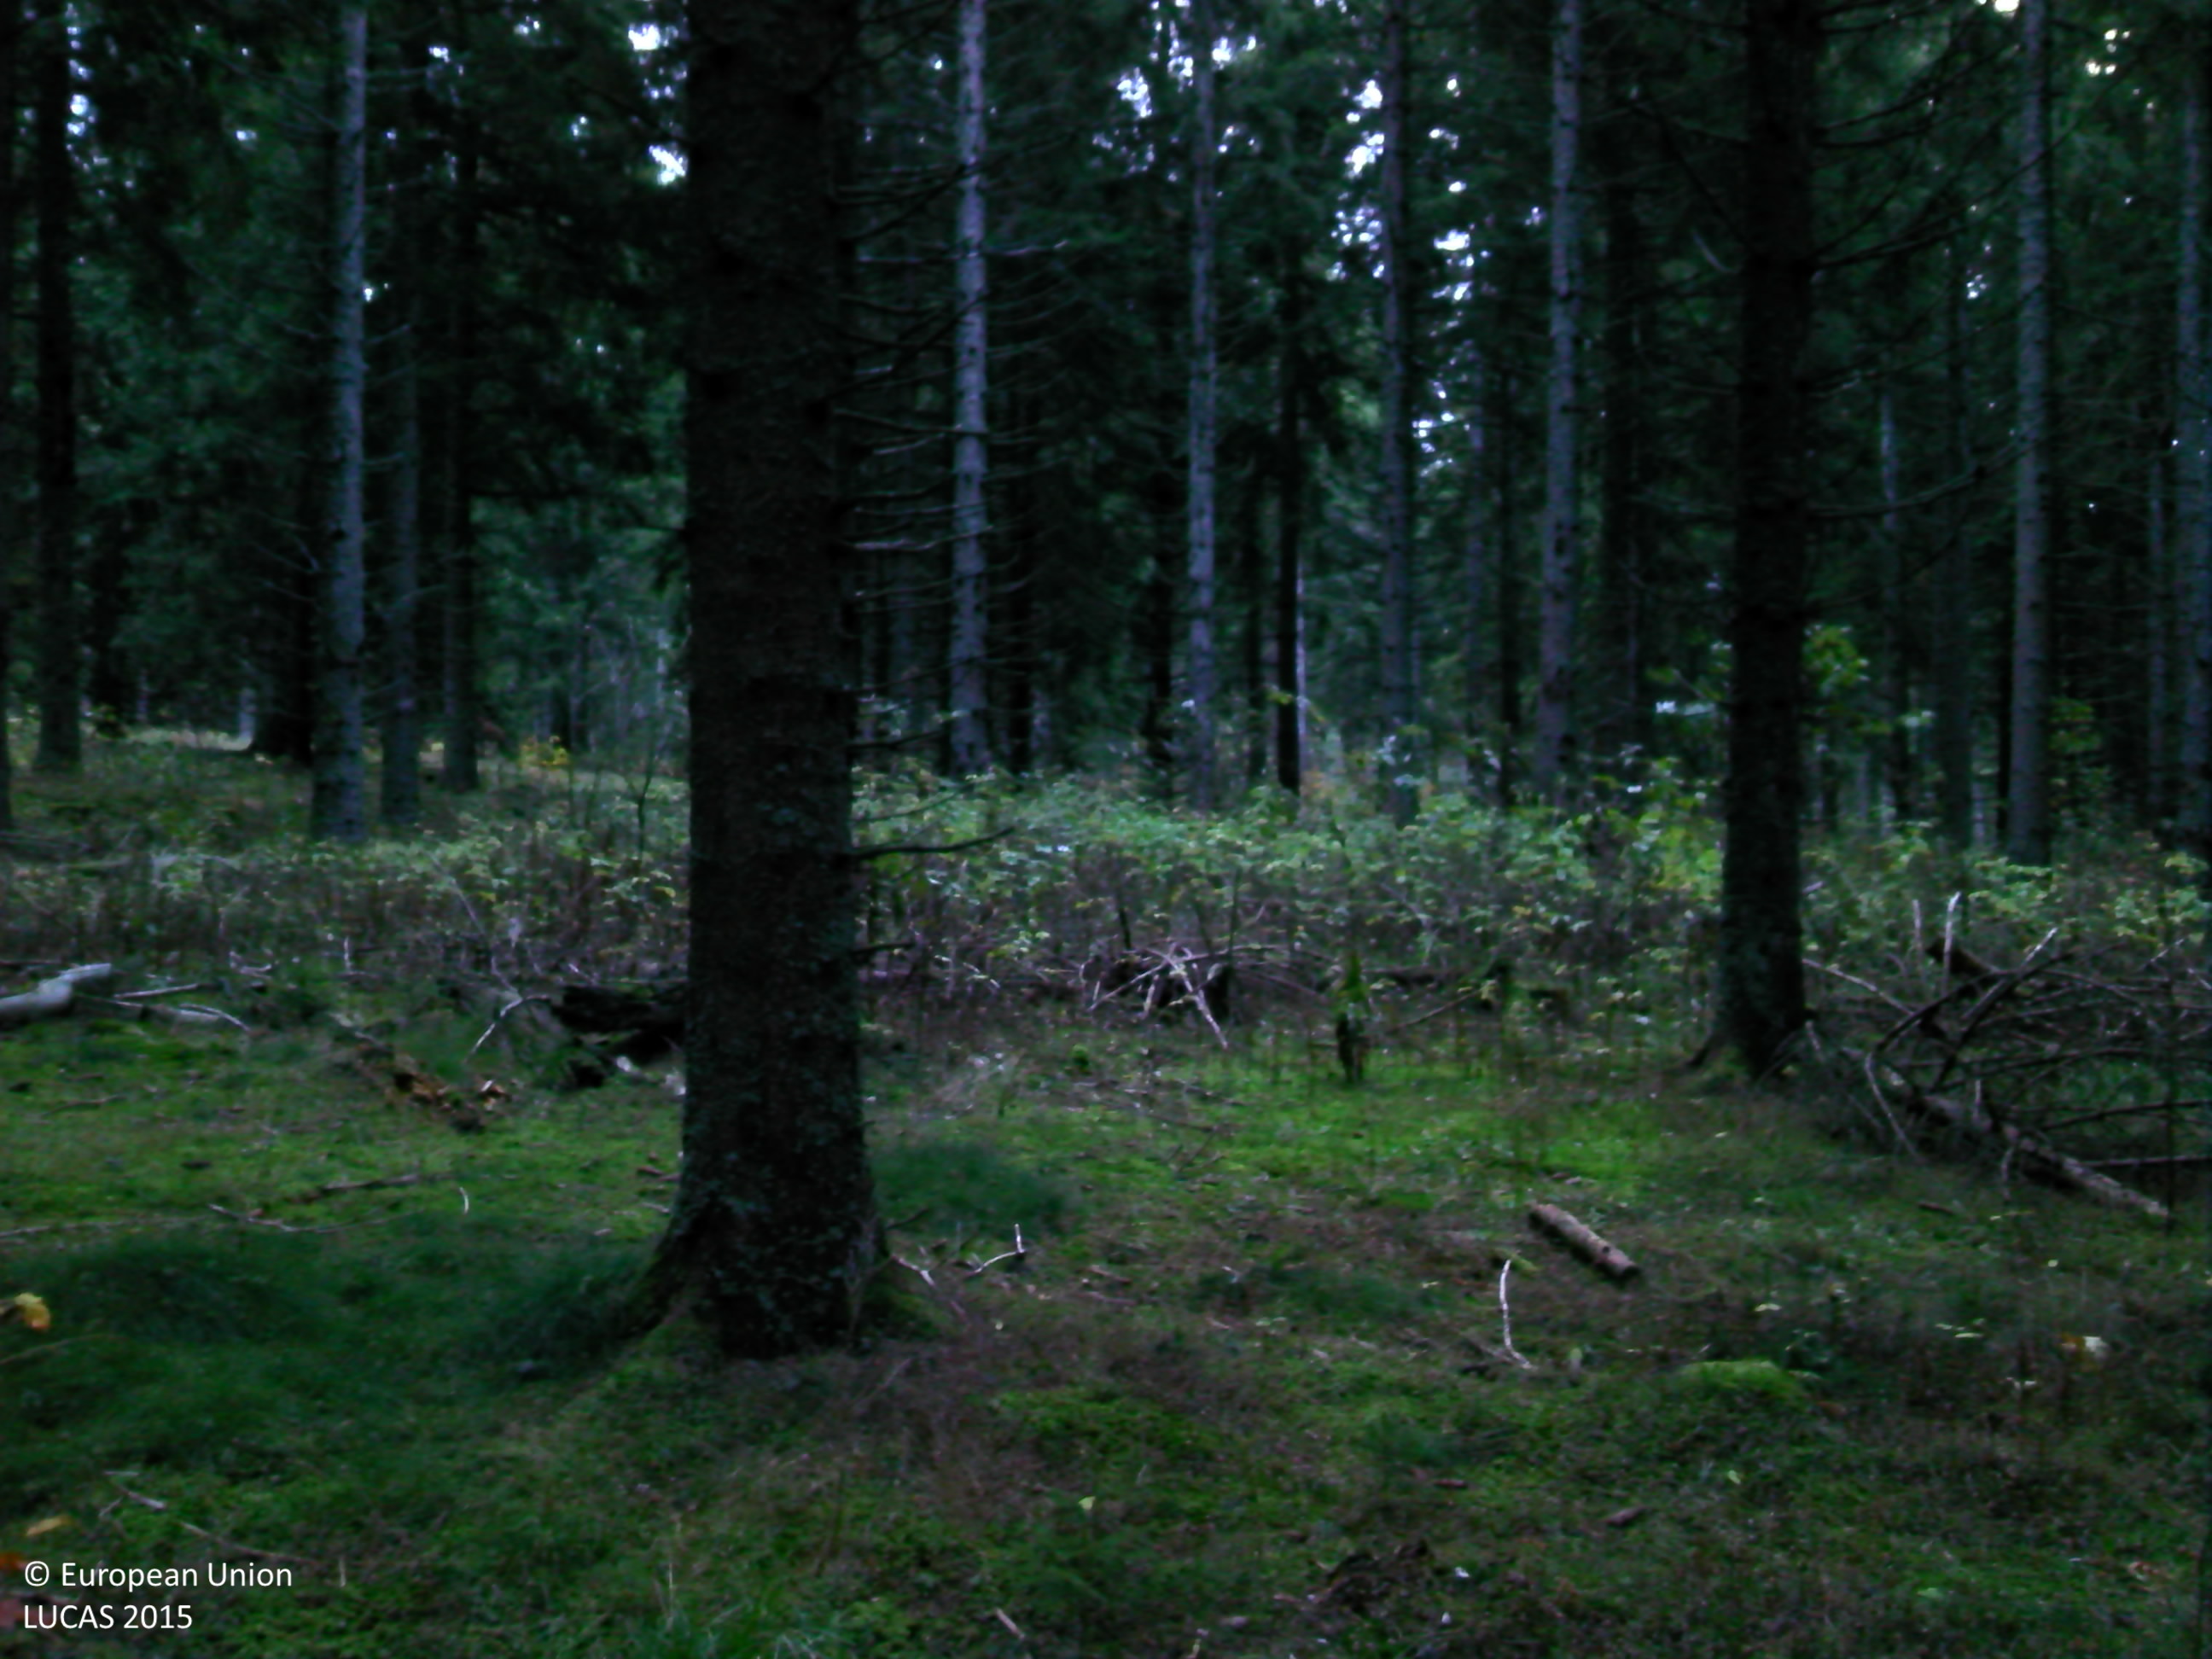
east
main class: Woodland
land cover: Spruce dominated coniferous woodland
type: exotic forest
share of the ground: > 75 %
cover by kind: coniferous forest trees 80 %, shrubs 10 %, herbaceous plants 5 %, lichens and mosses 5 %
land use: Forestry
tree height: > 5 m
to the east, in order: Spruce dominated coniferous woodland; Spontaneously vegetated surfaces; Spruce dominated coniferous woodland
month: October
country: FR
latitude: 44.7679
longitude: 3.9024
